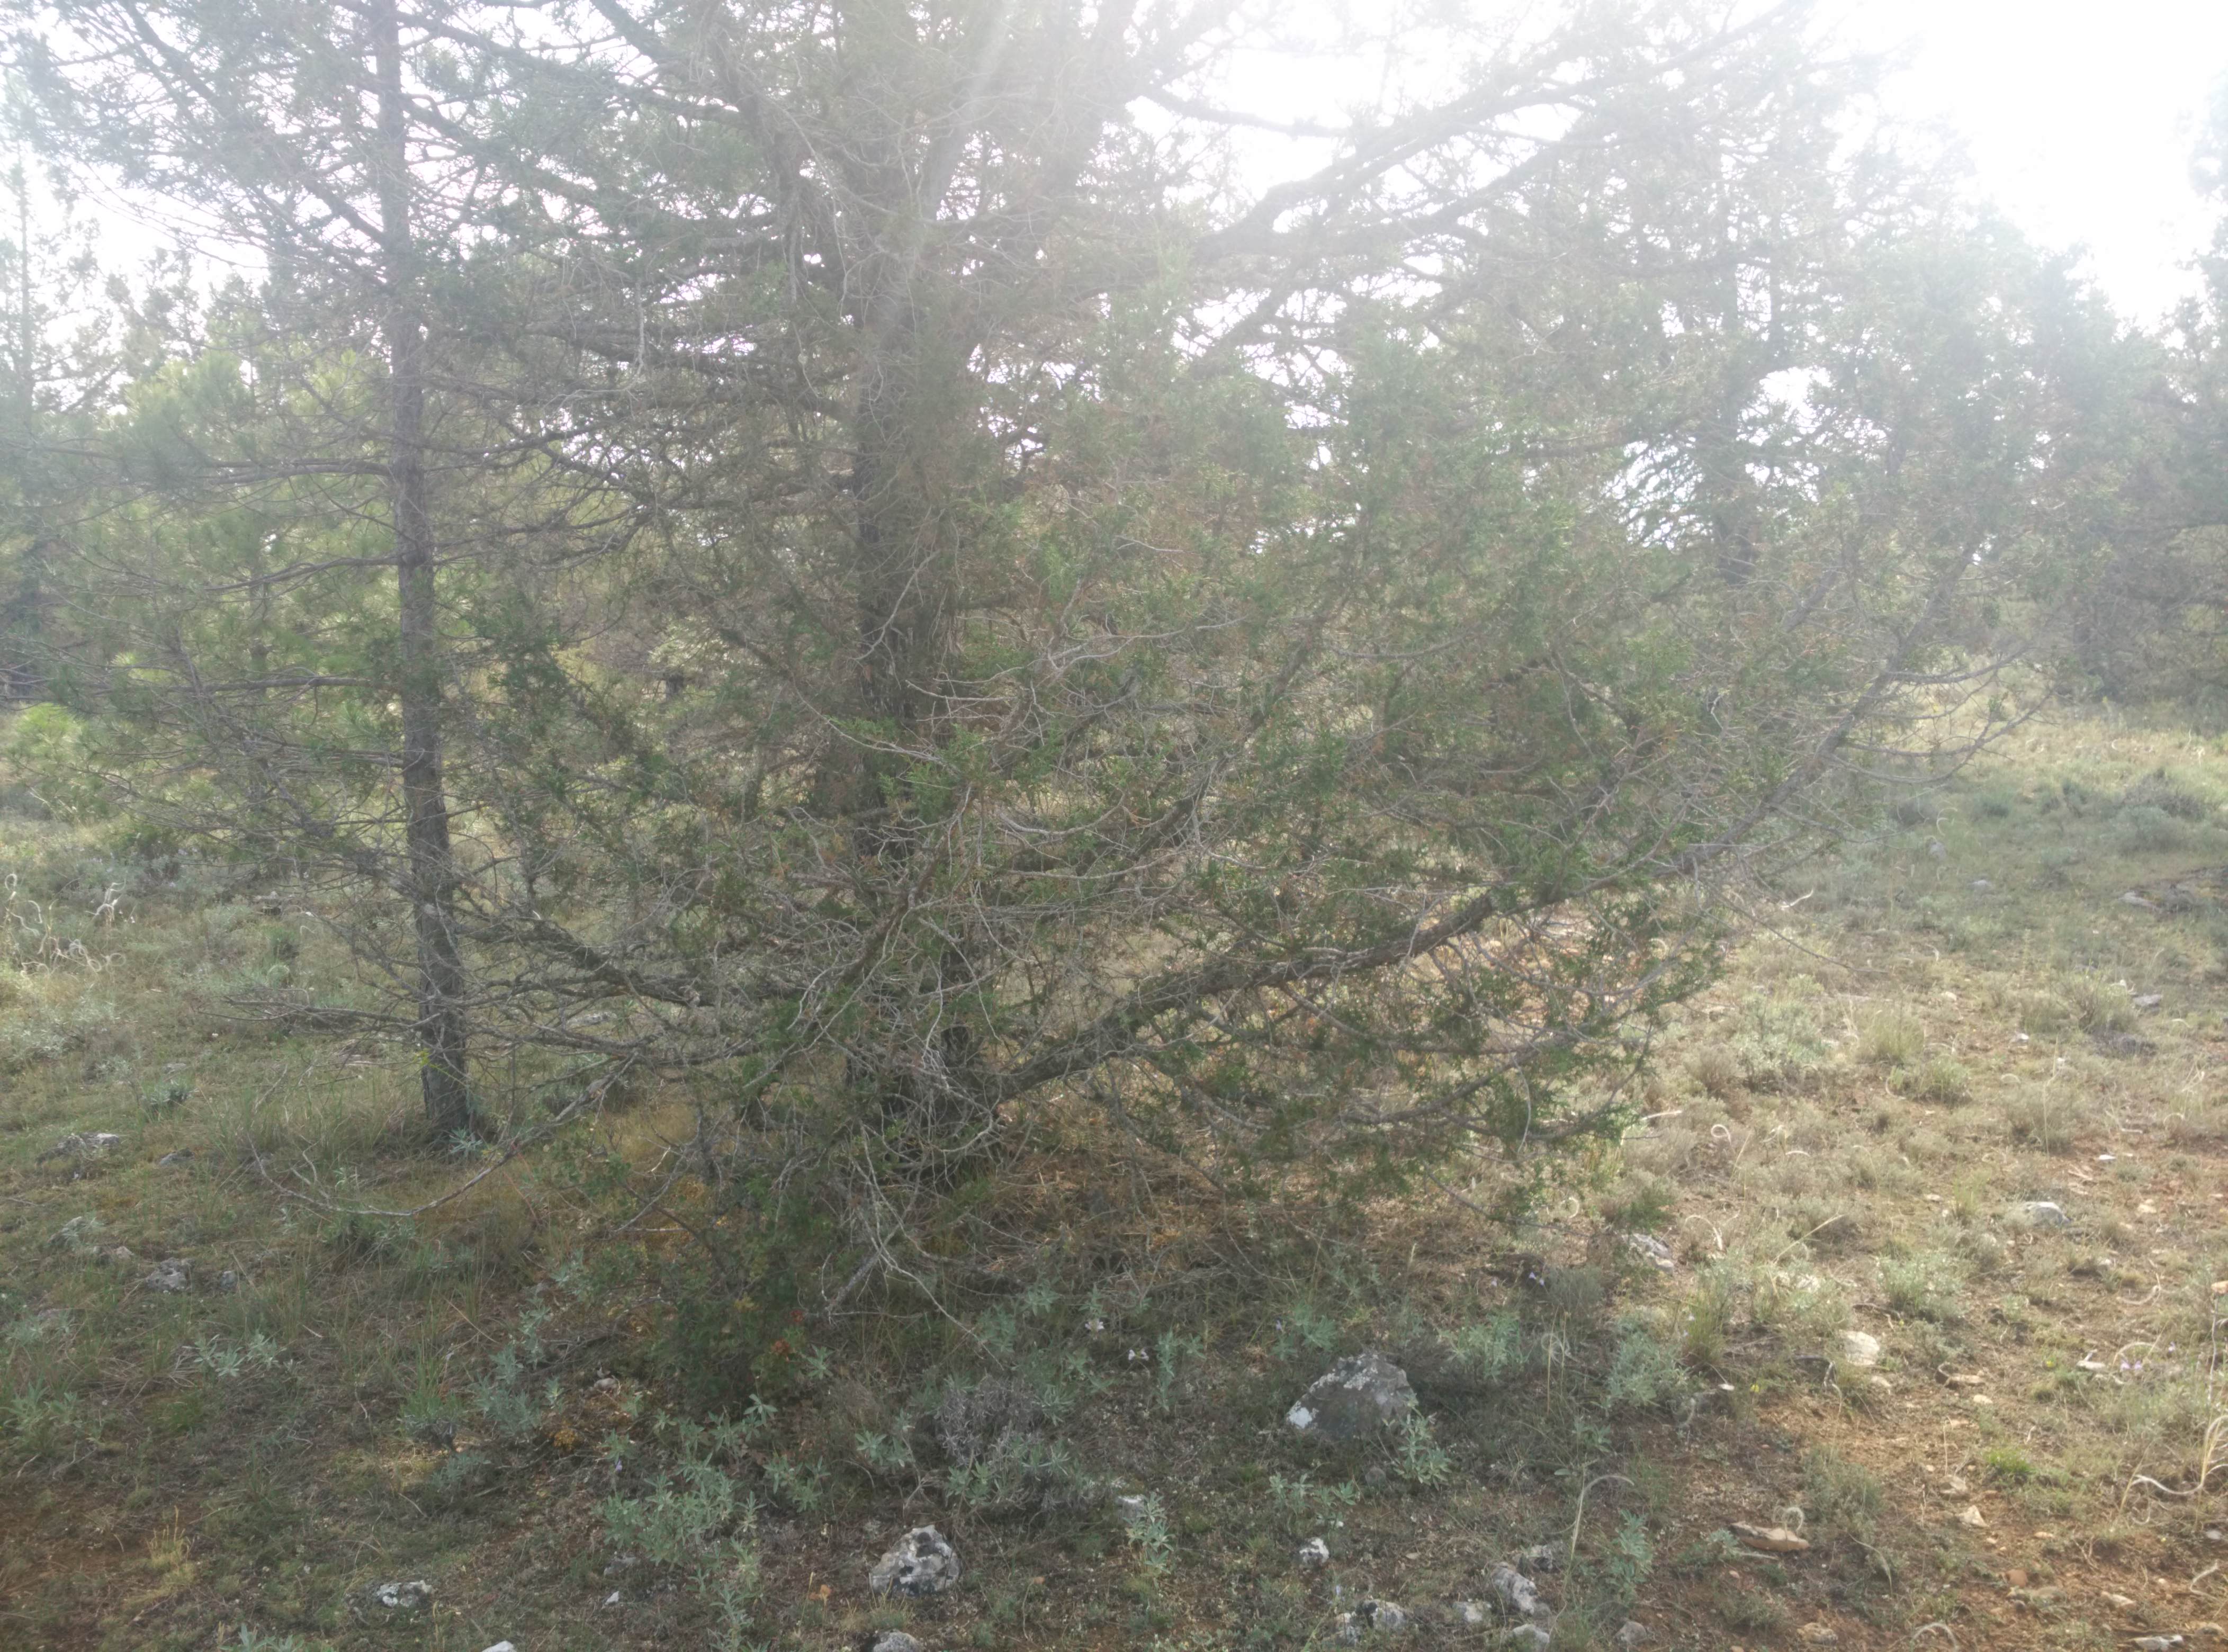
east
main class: Woodland
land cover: Pine dominated coniferous woodland
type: coniferous forest of the mediterranean region
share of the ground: 25 - 50 %
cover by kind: unconsolidated bare surface 40 %, coniferous forest trees 35 %, shrubs 20 %, herbaceous plants 5 %
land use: Semi-natural and natural areas not in use
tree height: > 5 m
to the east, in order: Pine dominated coniferous woodland
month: June
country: ES
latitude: 40.7343
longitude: -1.9933
